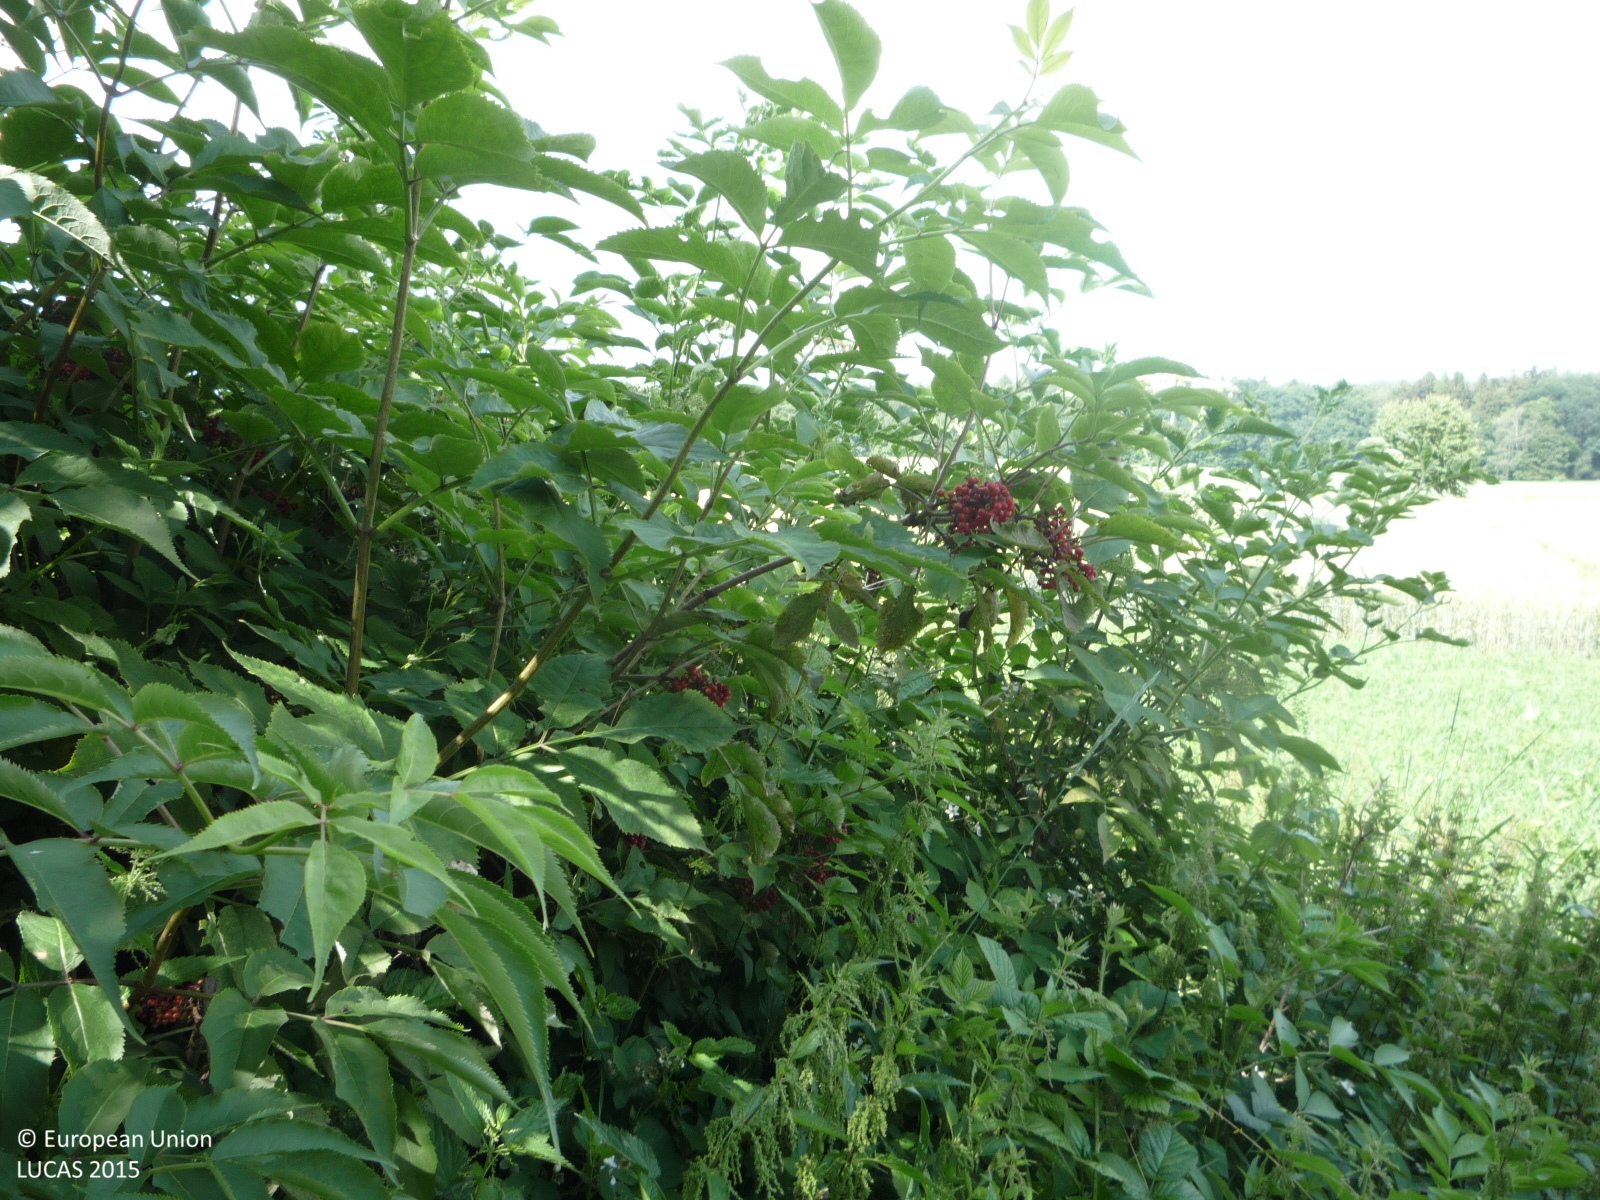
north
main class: Woodland
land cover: Spruce dominated coniferous woodland
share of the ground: 25 - 50 %
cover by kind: coniferous forest trees 40 %, herbaceous plants 40 %, shrubs 20 %
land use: Forestry
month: June
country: CZ
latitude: 49.9389
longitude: 15.5915
